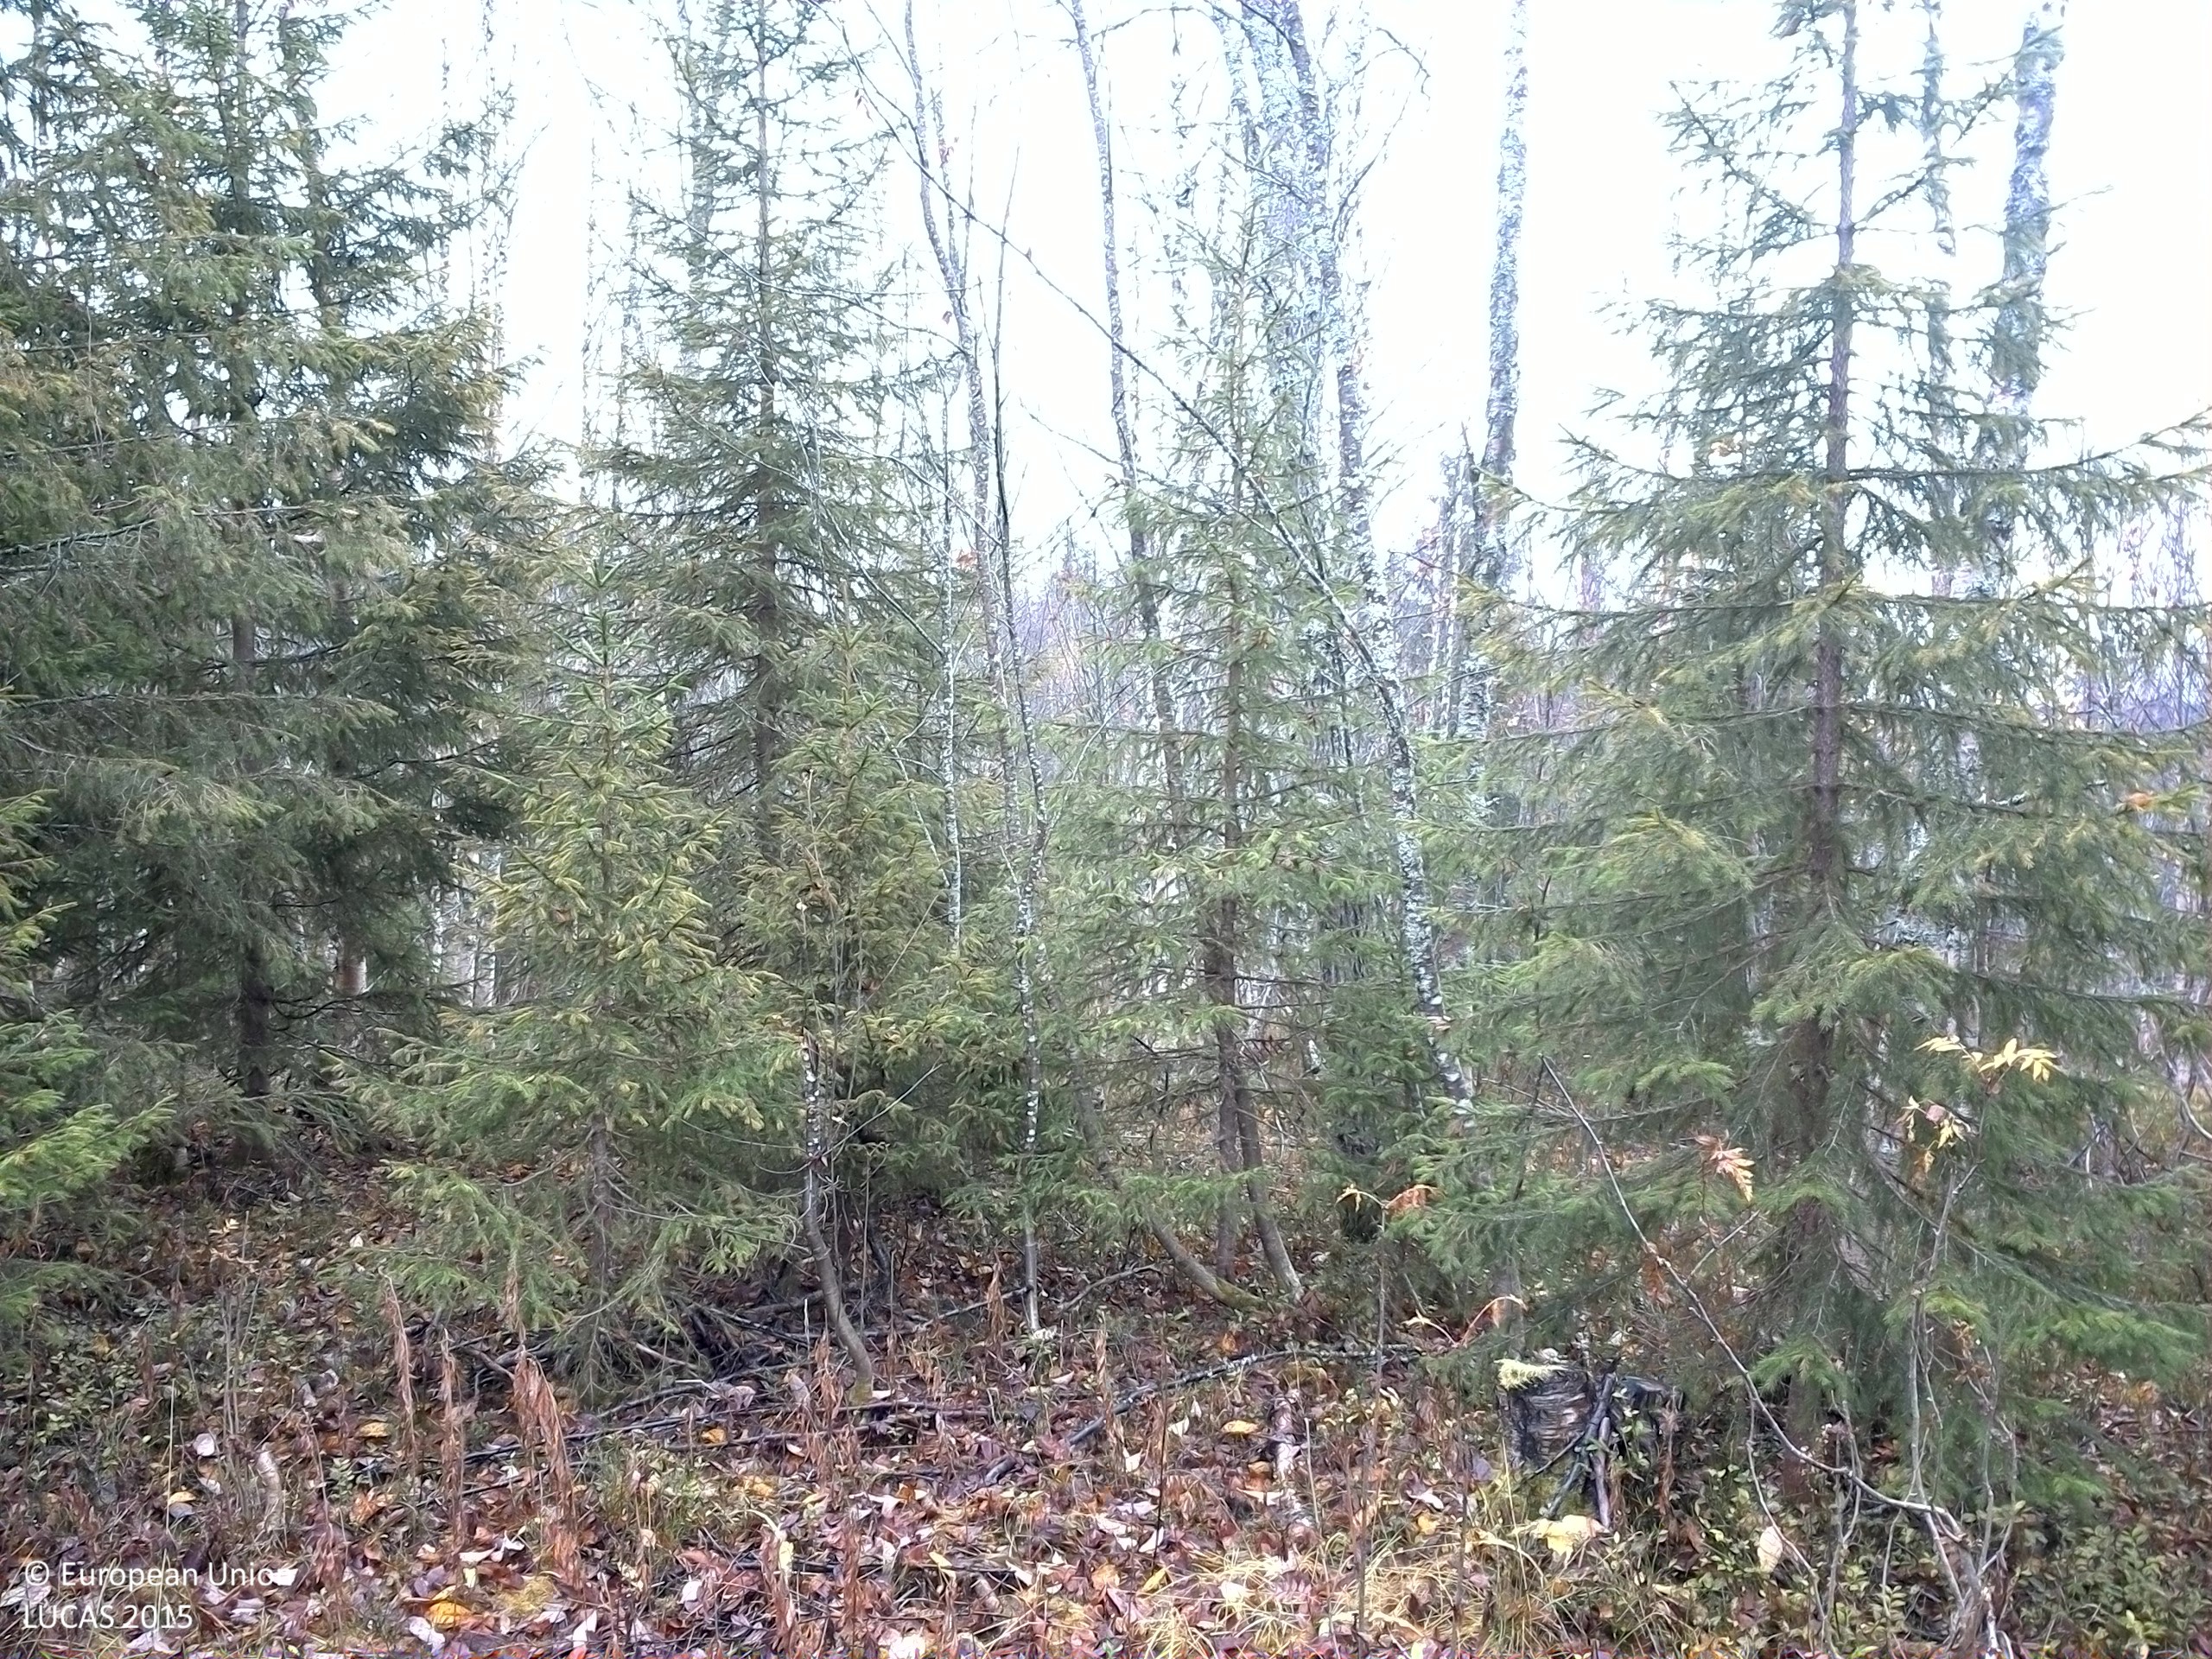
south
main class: Woodland
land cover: Spruce dominated mixed woodland
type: boreal forest
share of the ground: 50 - 75 %
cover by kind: broadleaved forest trees 55 %, coniferous forest trees 20 %, shrubs 15 %, lichens and mosses 10 %
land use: Forestry
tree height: > 5 m
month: October
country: SE
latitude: 64.7277
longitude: 13.9848
